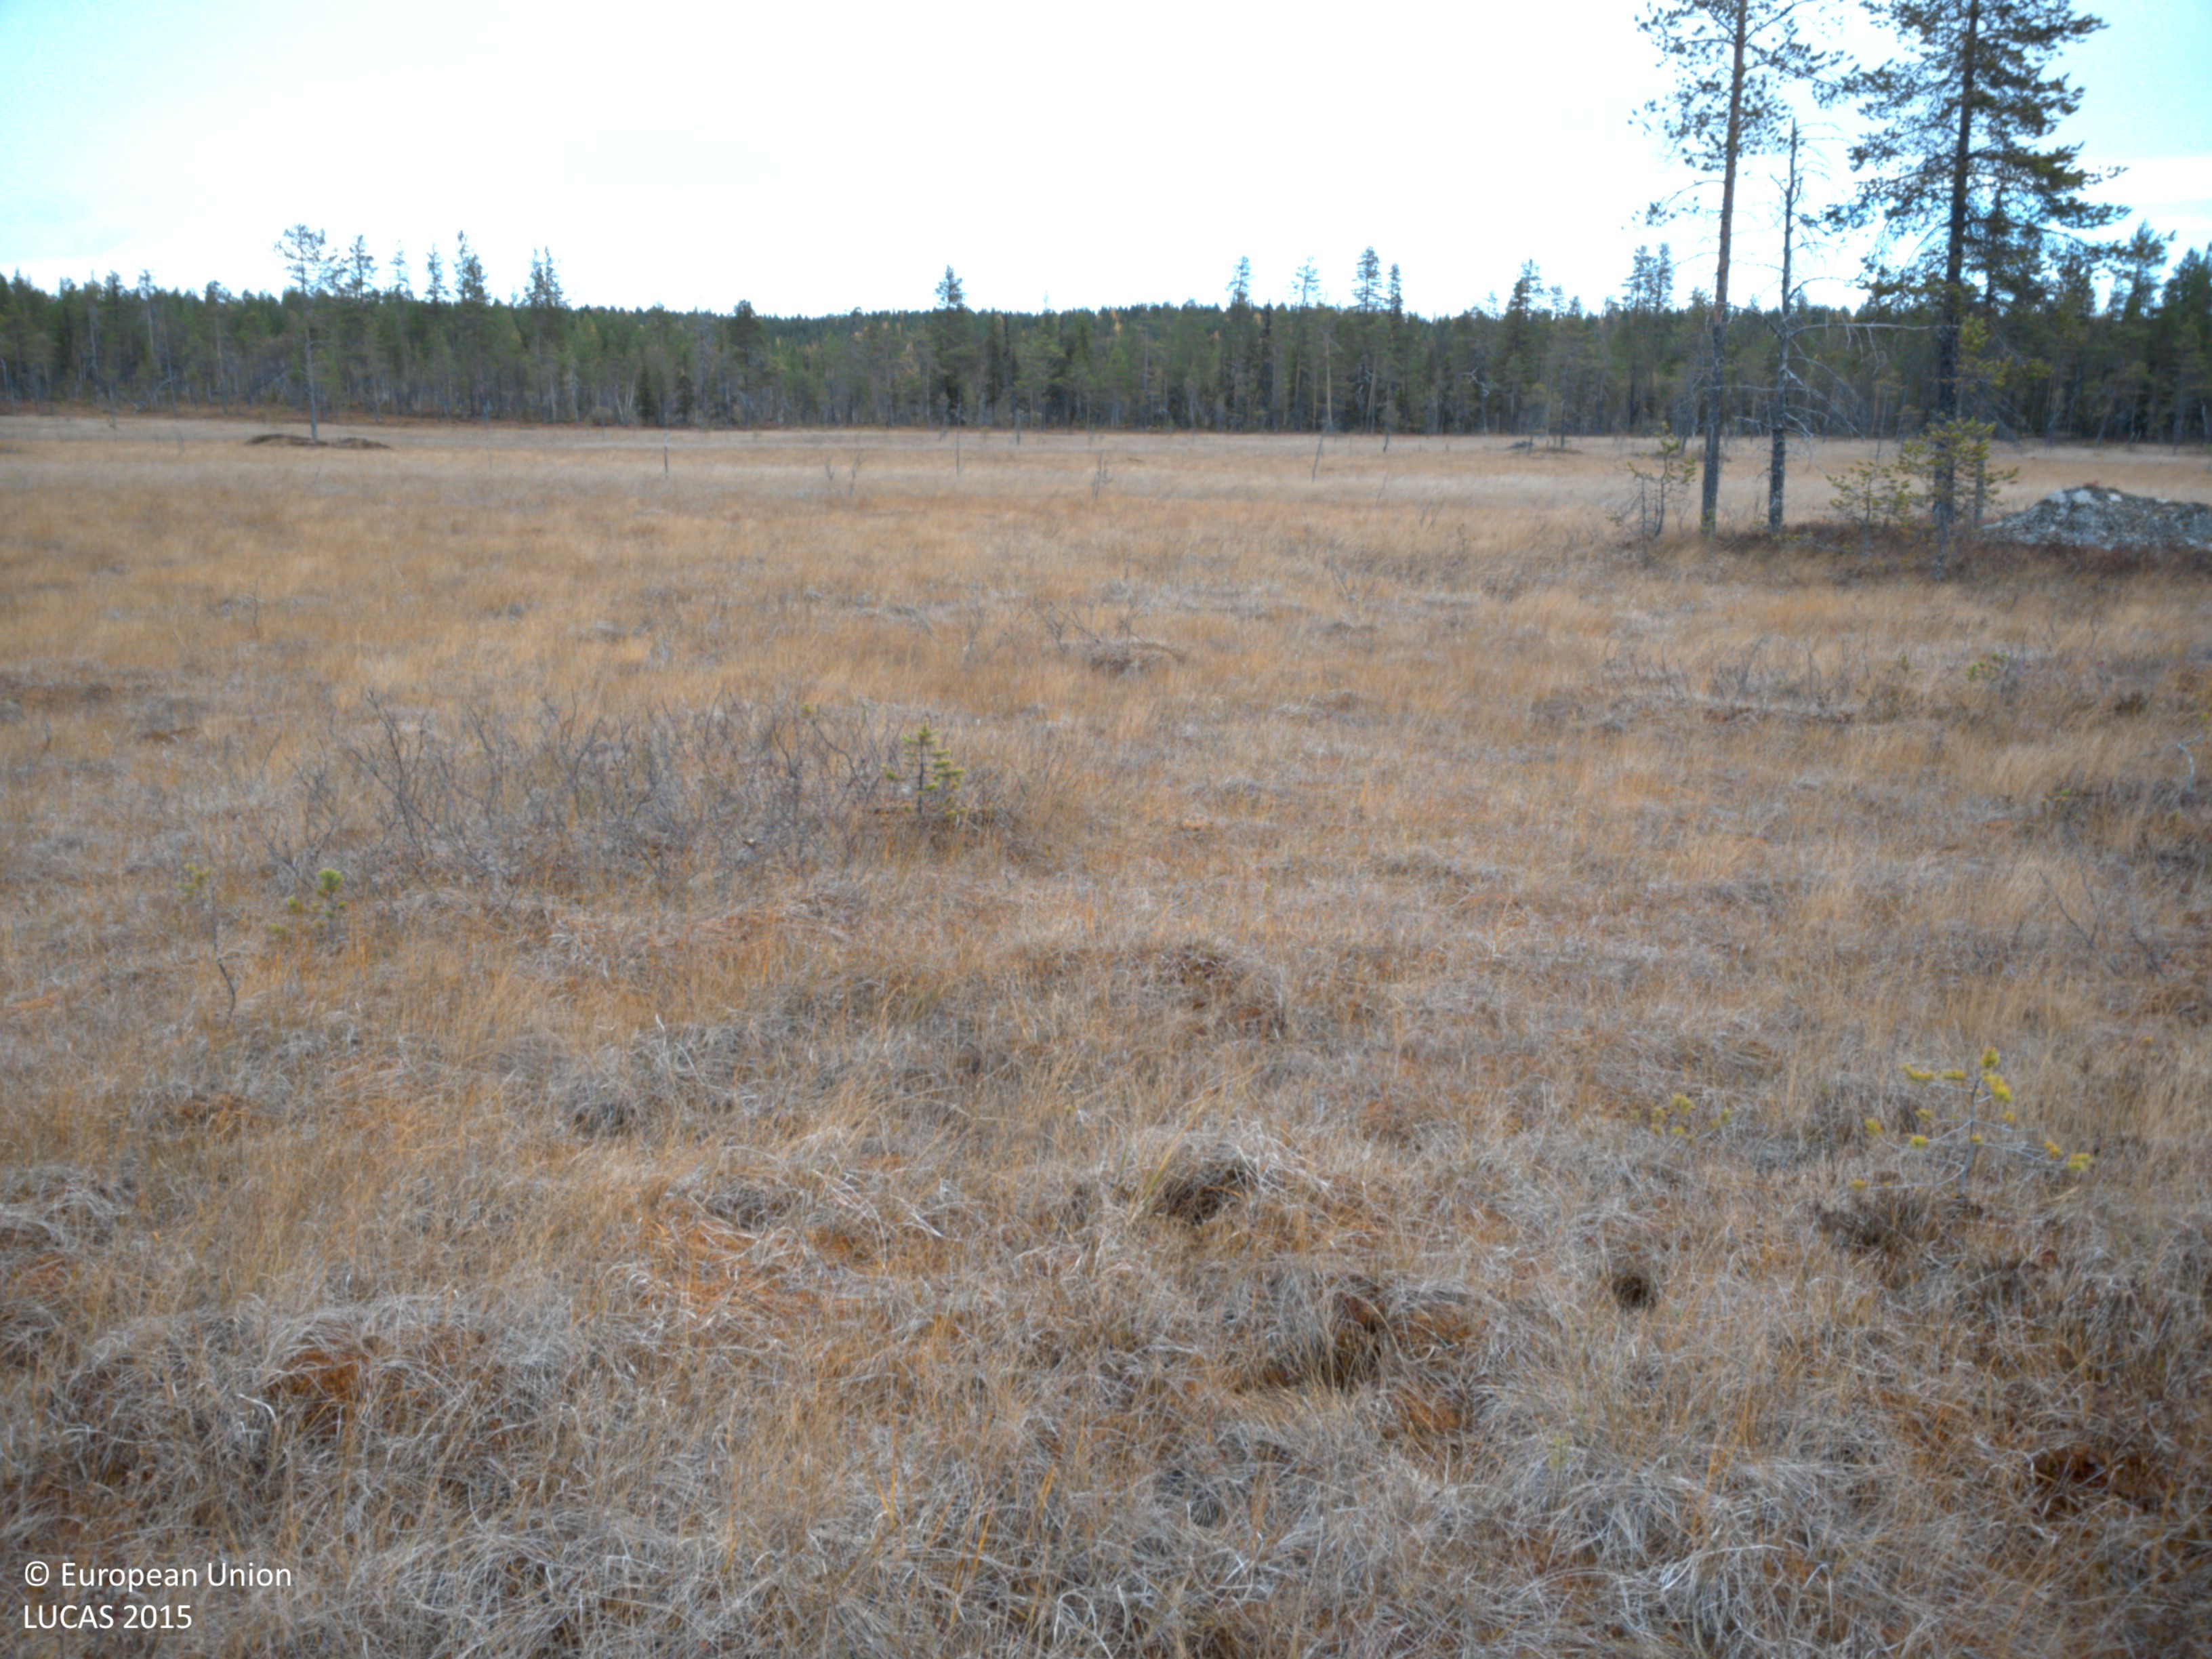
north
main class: Woodland
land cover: Pine dominated coniferous woodland
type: boreal forest
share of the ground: 10 - 25 %
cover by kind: herbaceous plants 45 %, shrubs 25 %, coniferous forest trees 15 %, lichens and mosses 15 %
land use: Semi-natural and natural areas not in use
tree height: < 5 m
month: October
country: SE
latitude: 65.0211
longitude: 18.2196
